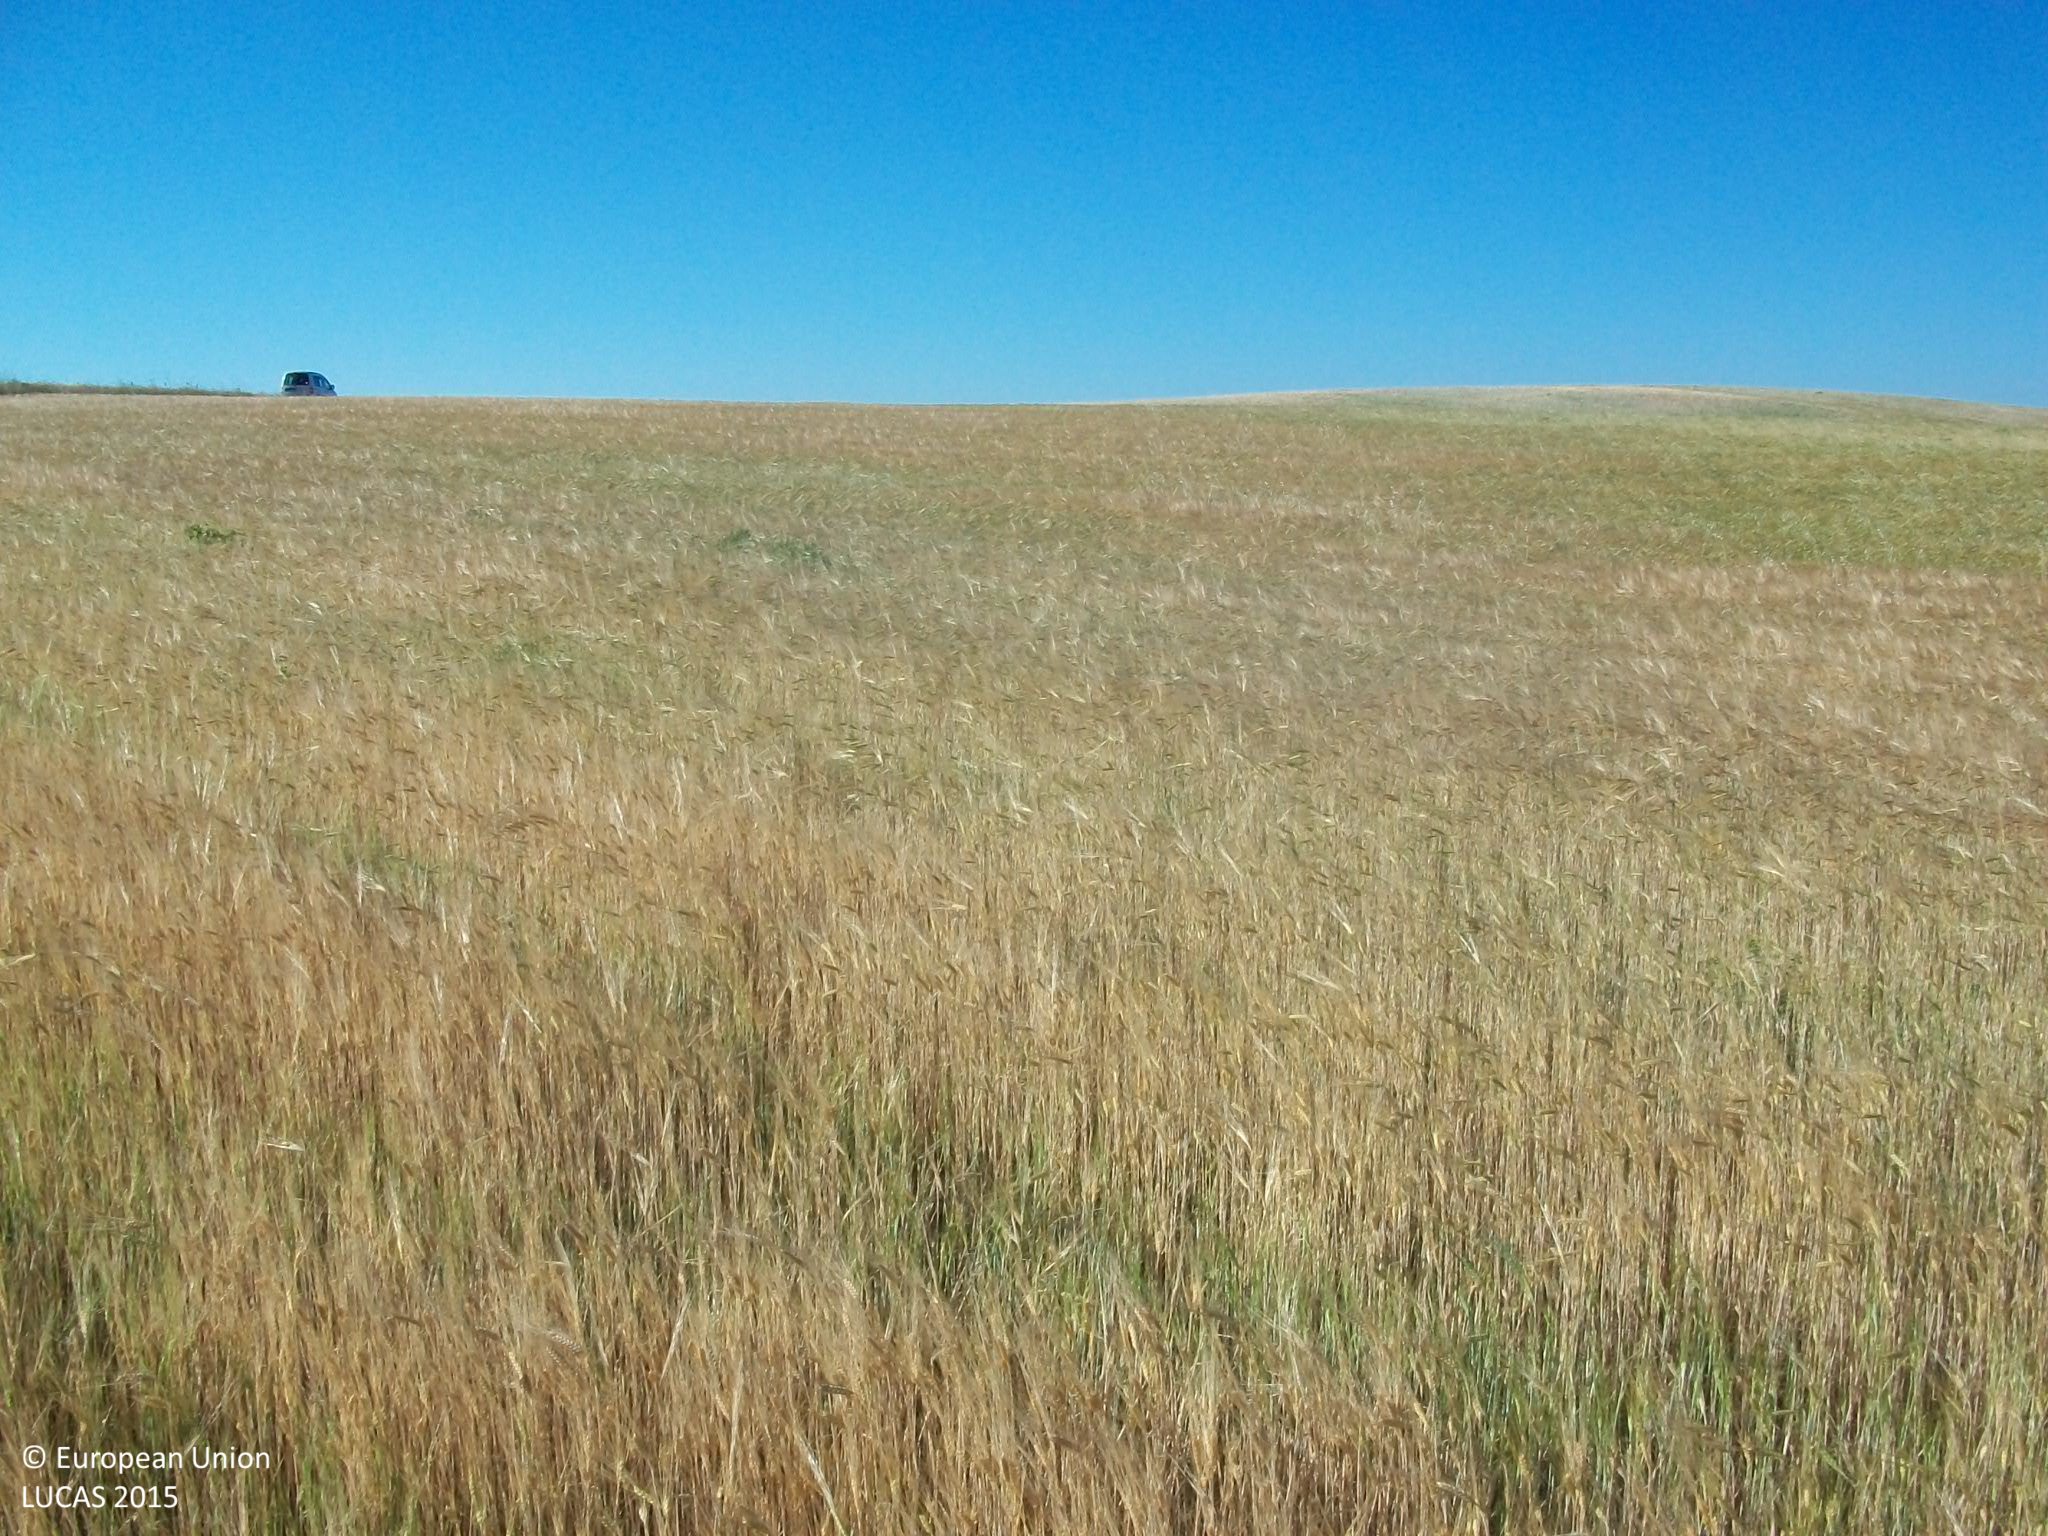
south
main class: Cropland
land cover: Barley
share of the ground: > 75 %
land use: Agriculture (excluding fallow land and kitchen gardens)
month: May
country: ES
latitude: 39.9020
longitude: -3.7277
